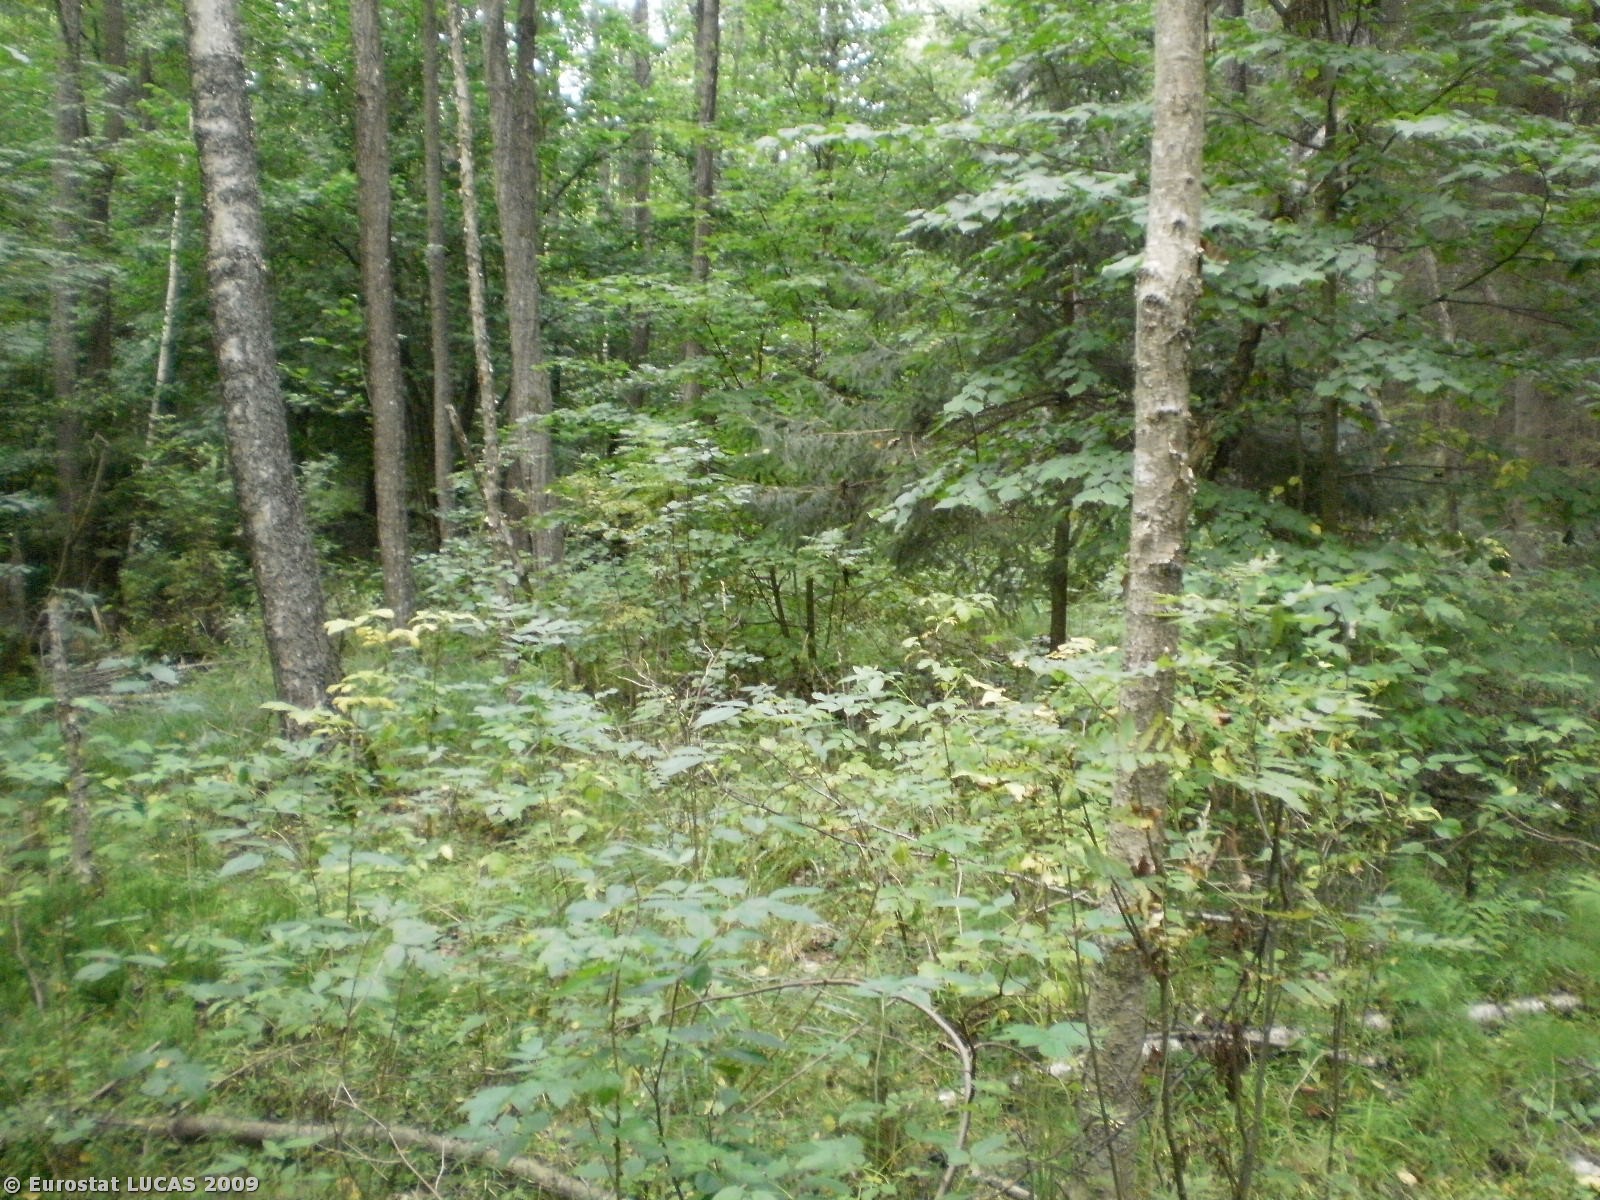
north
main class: Woodland
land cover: Mixed woodland
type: hemiboreal forest and nemoral coniferous forest and mixed broadleaved-coniferous forest
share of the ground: > 75 %
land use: Forestry
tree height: > 5 m
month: August
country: PL
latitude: 54.1322
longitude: 22.1647
